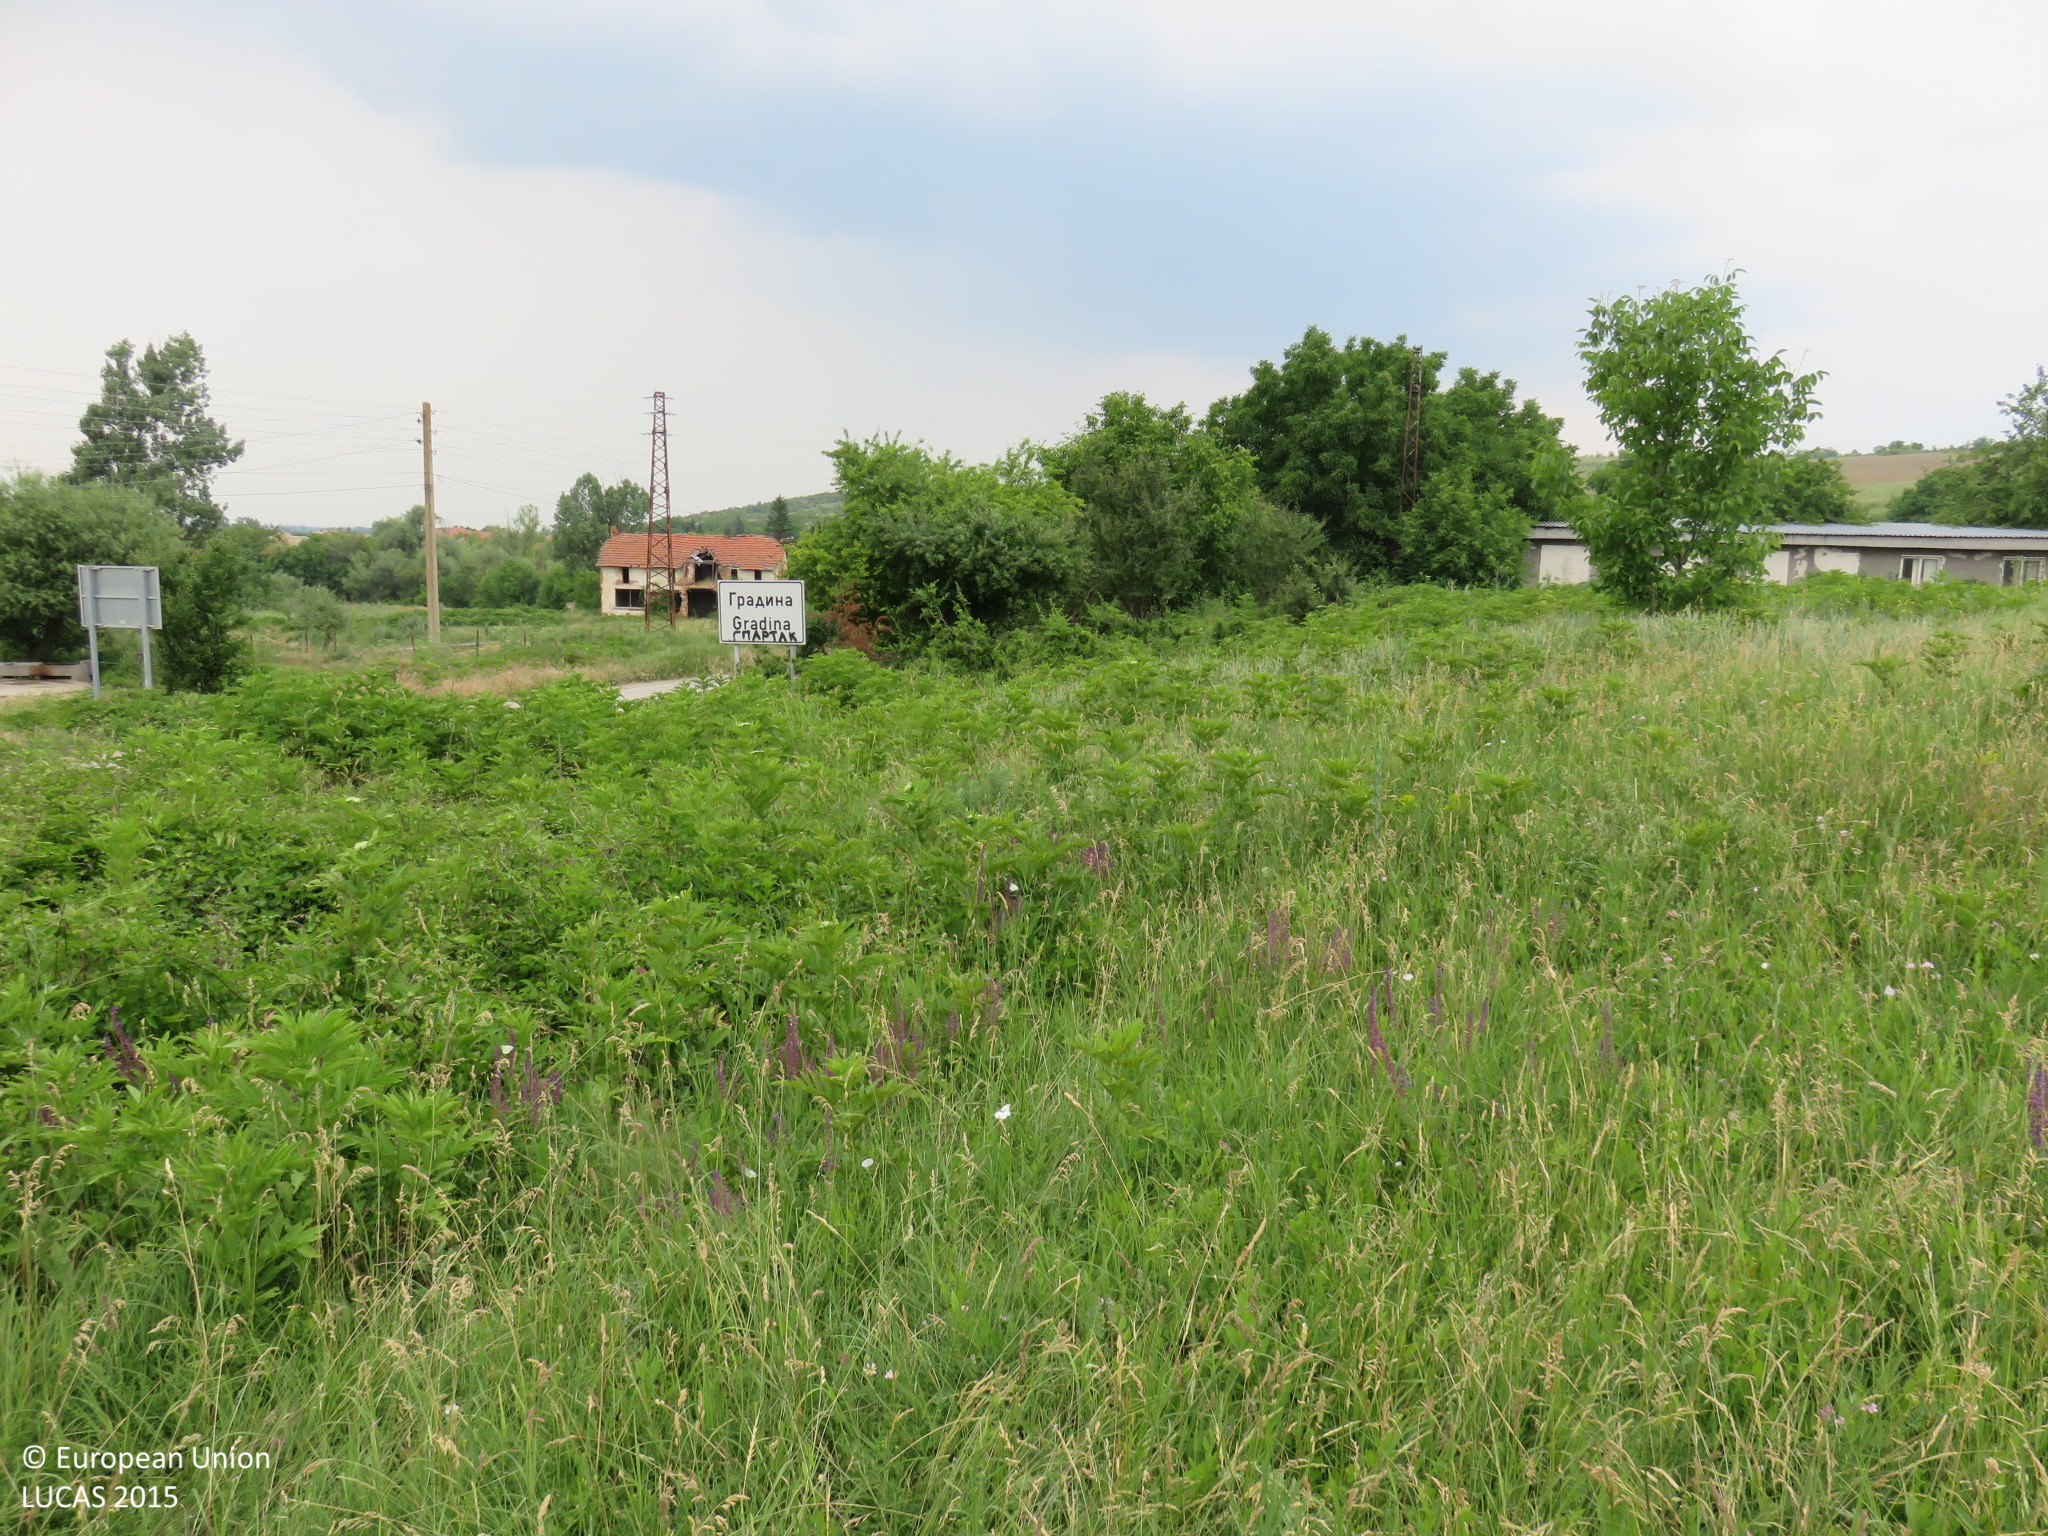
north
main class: Grassland
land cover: Grassland without tree/shrub cover
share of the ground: > 75 %
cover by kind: herbaceous plants 100 %
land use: Semi-natural and natural areas not in use
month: June
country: BG
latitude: 43.3468
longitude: 24.4809
